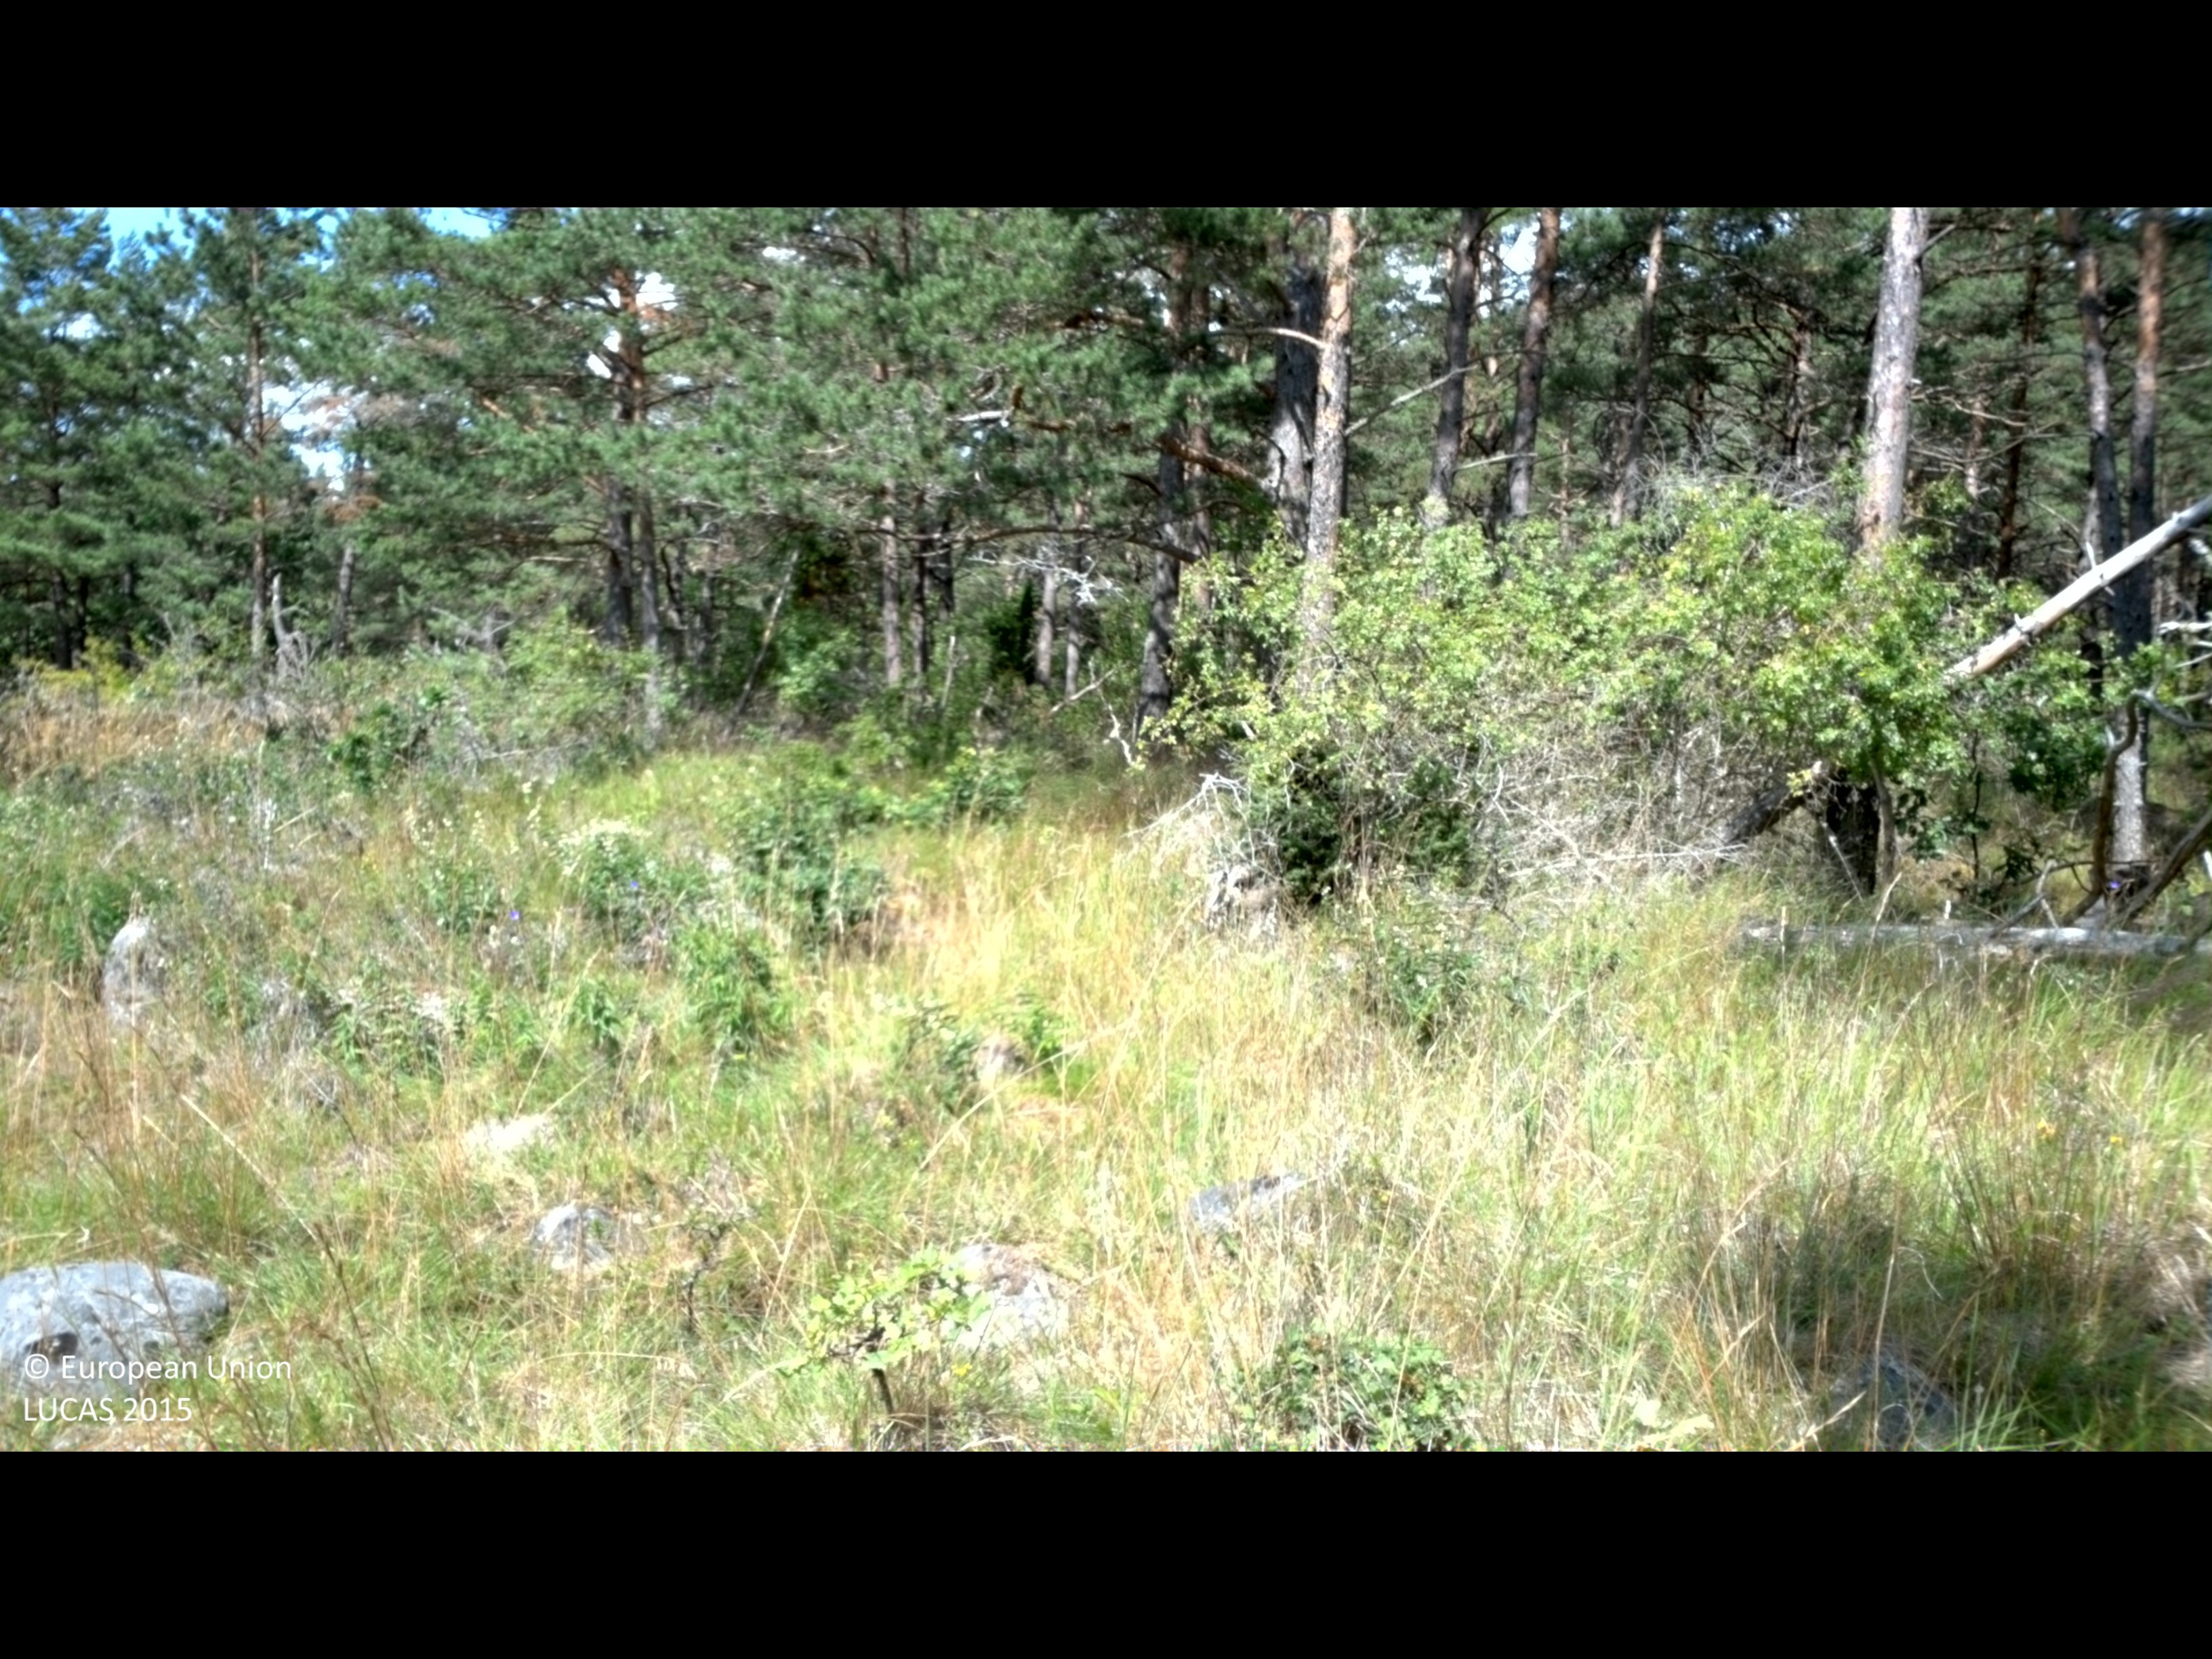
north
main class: Shrubland
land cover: Shrubland with sparse tree cover
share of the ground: 10 - 25 %
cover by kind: herbaceous plants 75 %, shrubs 20 %, coniferous forest trees 5 %
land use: Amenities, museums, leisure
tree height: < 5 m
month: July
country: SE
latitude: 57.3473
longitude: 17.0642
